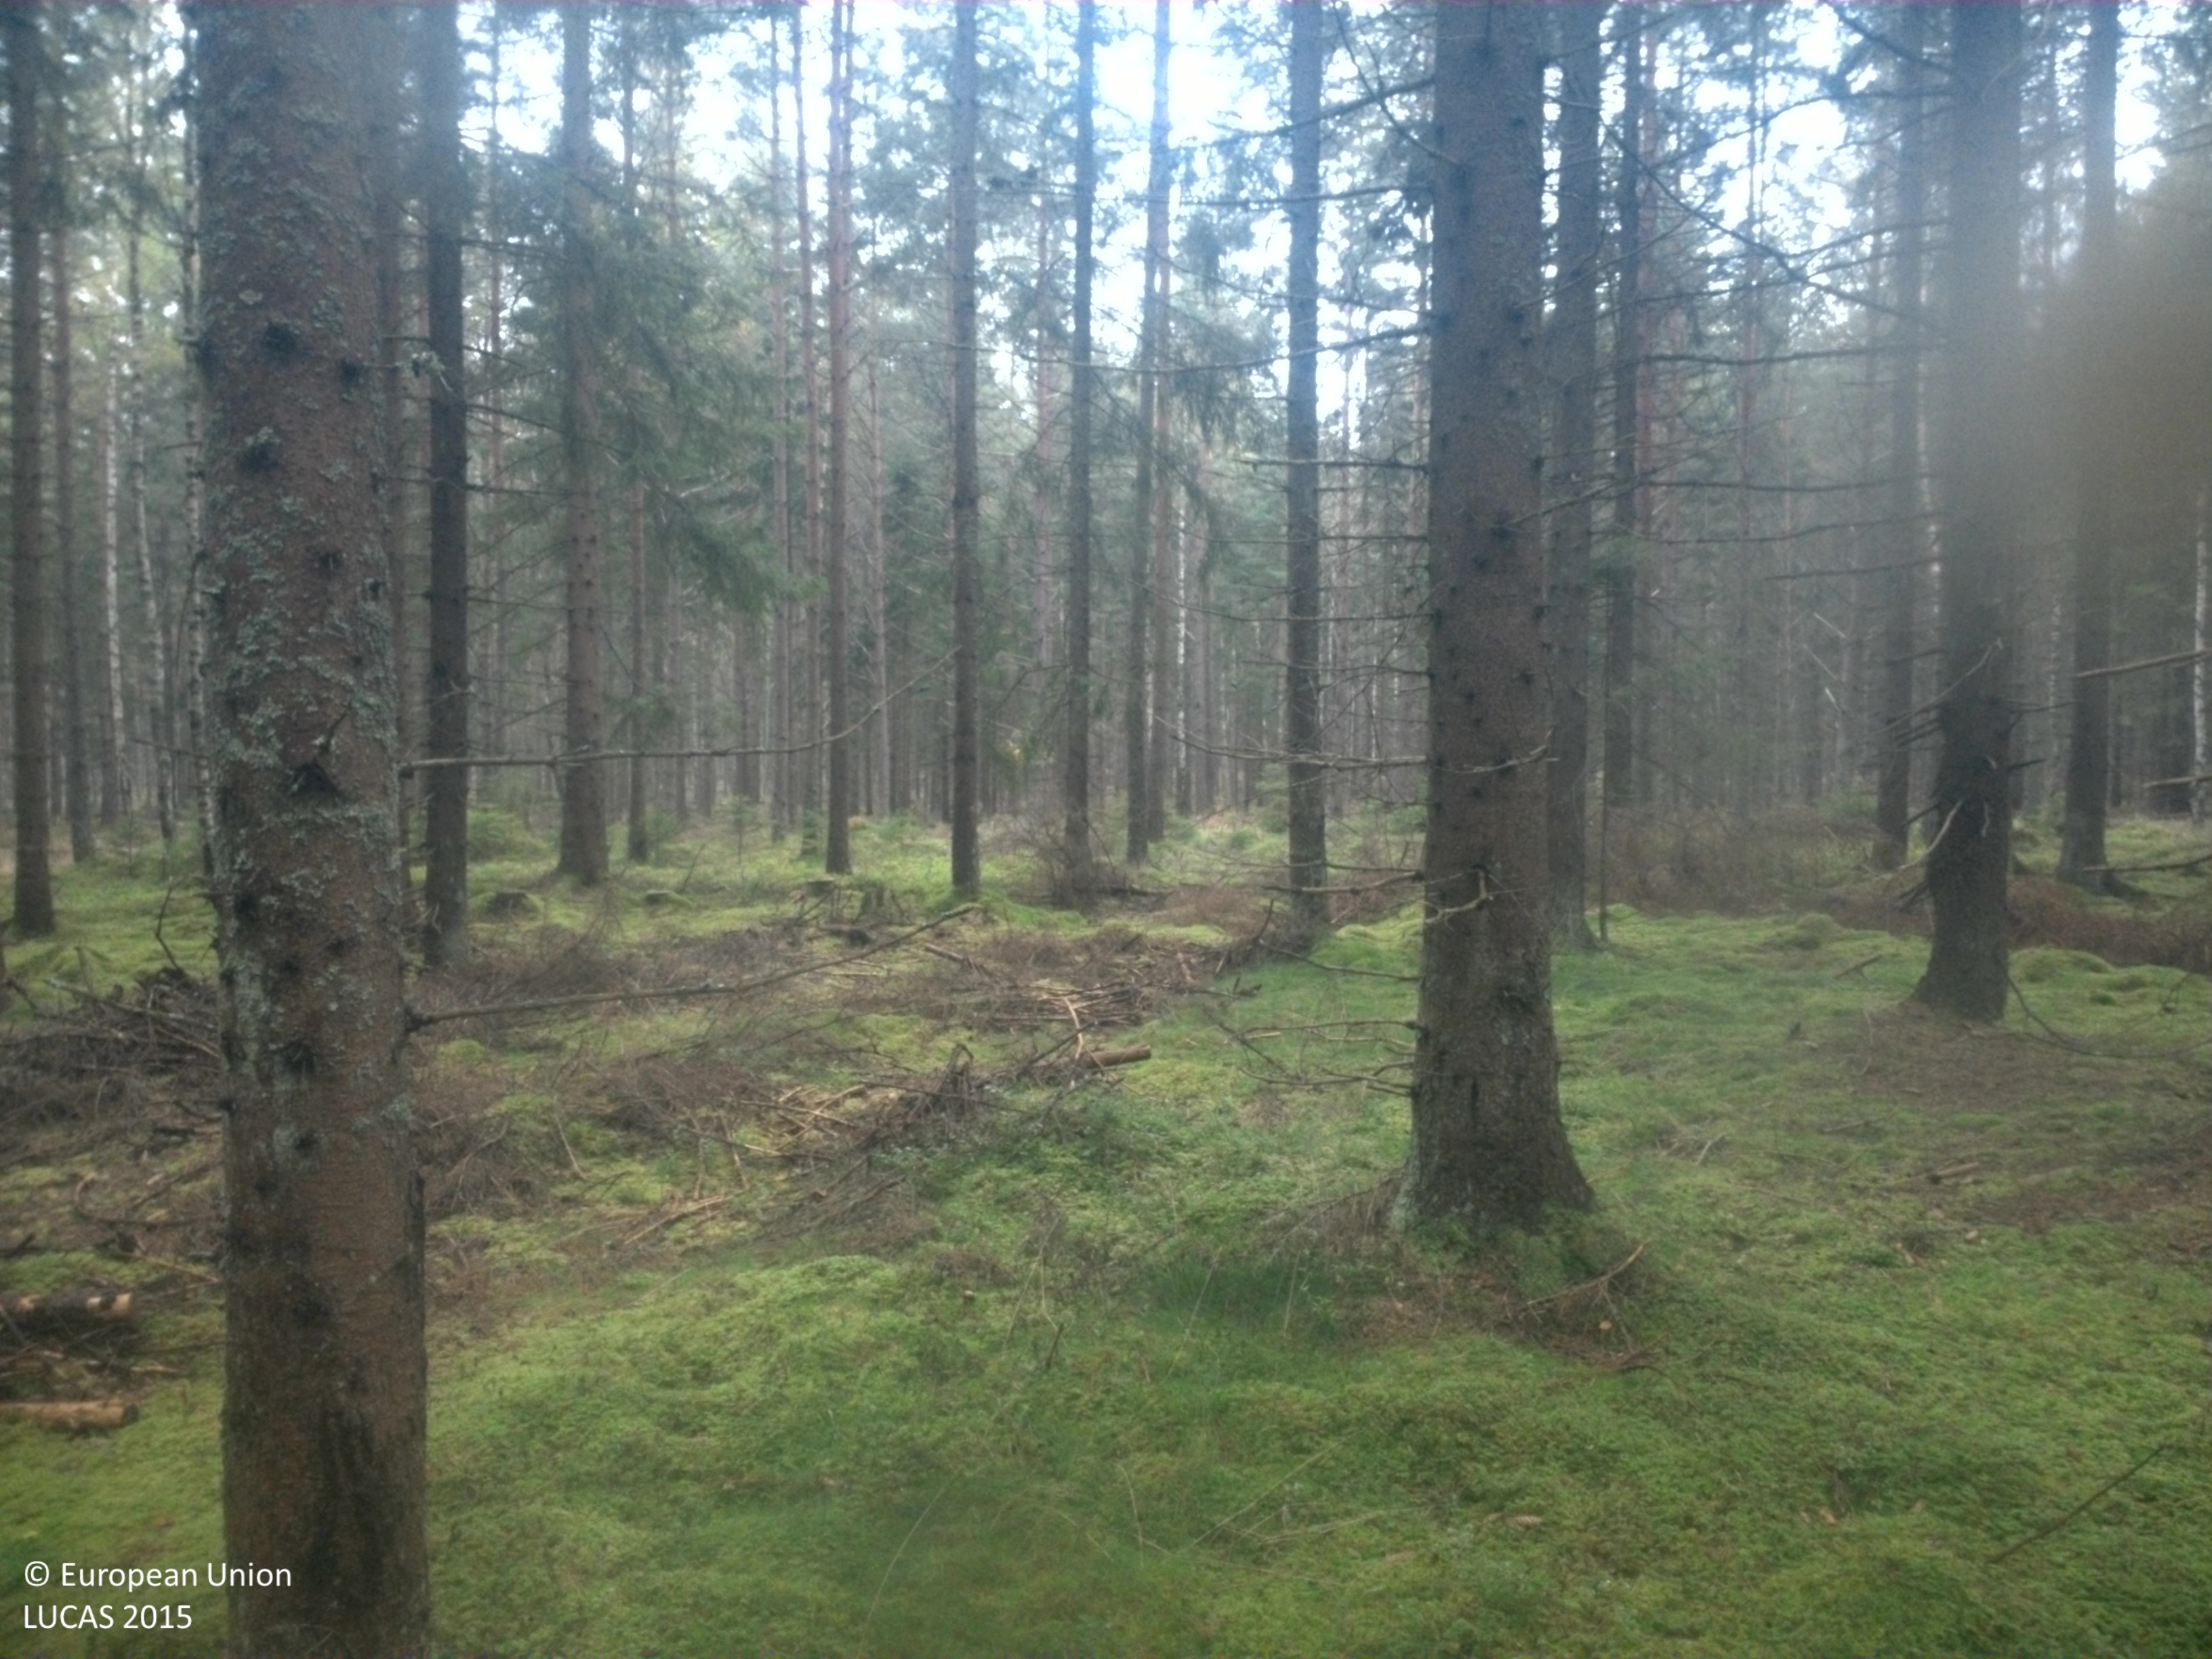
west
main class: Woodland
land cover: Spruce dominated coniferous woodland
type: boreal forest
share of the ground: 50 - 75 %
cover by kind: coniferous forest trees 60 %, lichens and mosses 25 %, shrubs 15 %
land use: Forestry
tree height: > 5 m
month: September
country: SE
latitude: 58.7718
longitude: 14.0223
